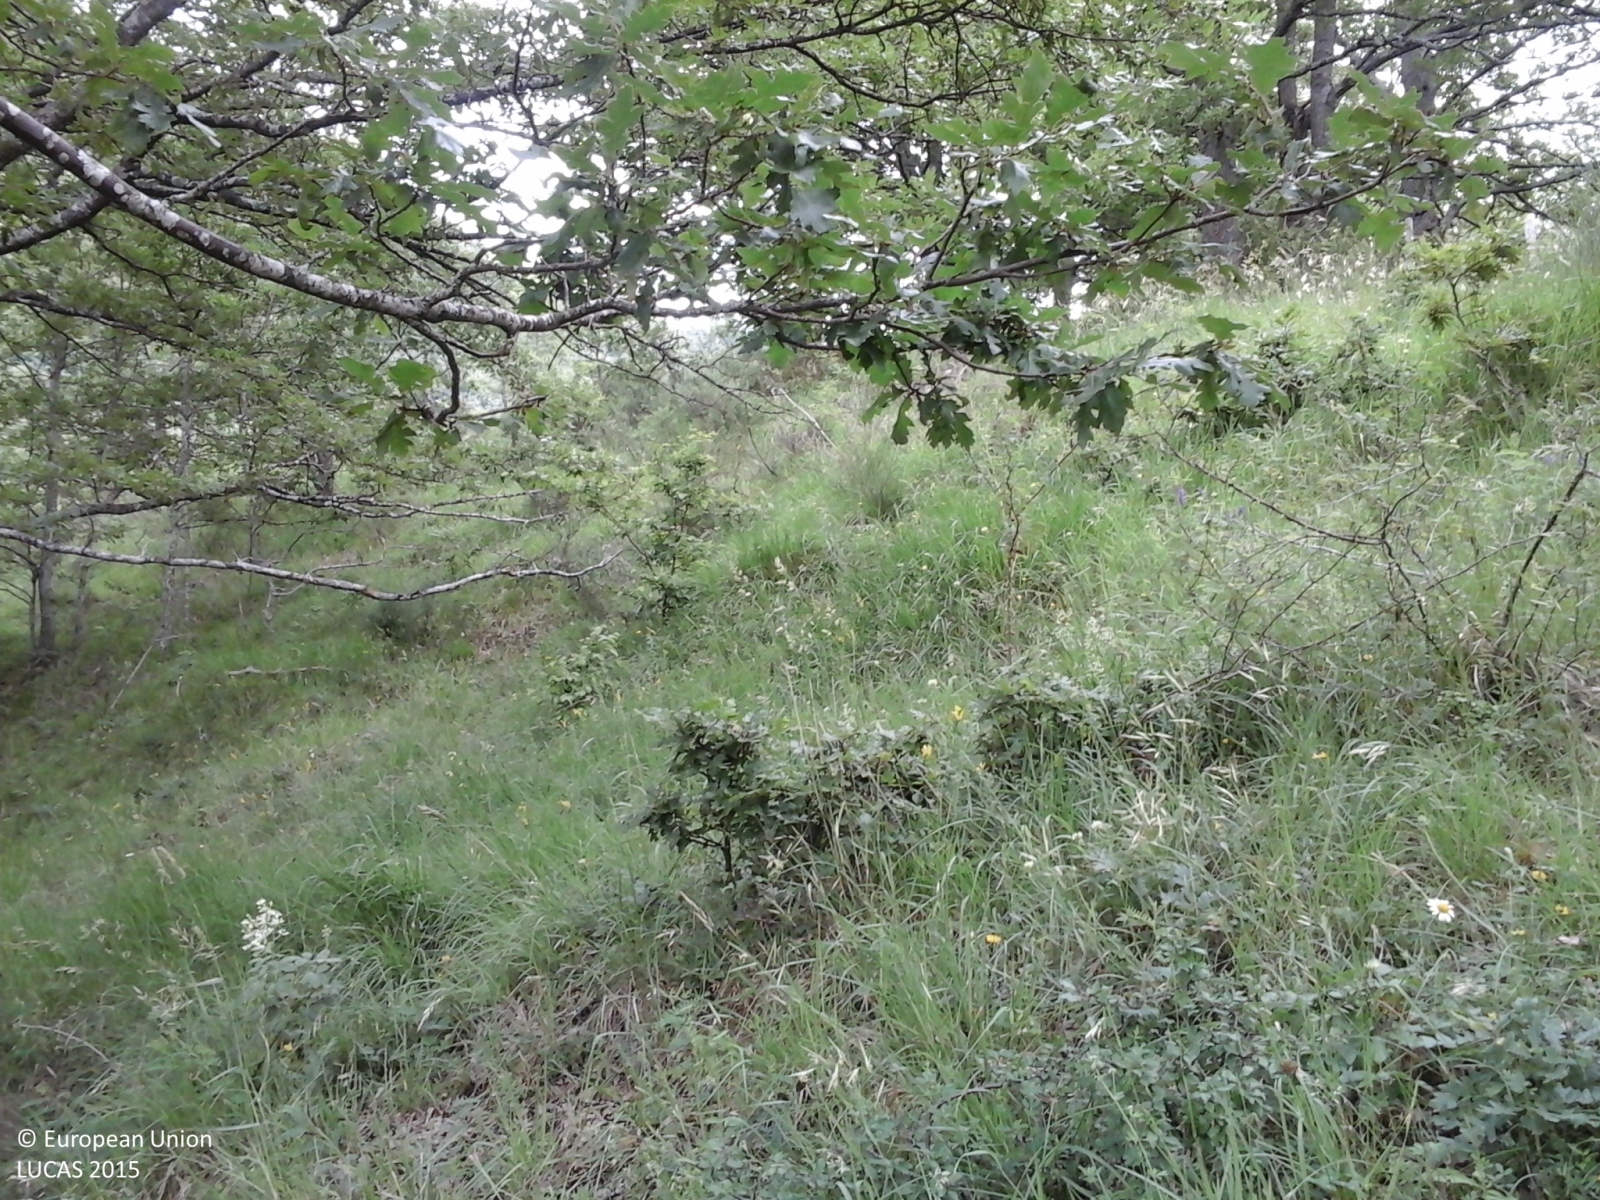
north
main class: Woodland
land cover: Broadleaved woodland
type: thermophilous deciduous forest
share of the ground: > 75 %
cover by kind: broadleaved forest trees 80 %, coniferous forest trees 10 %, shrubs 10 %
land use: Forestry
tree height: > 5 m
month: June
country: IT
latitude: 43.7919
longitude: 11.8966
